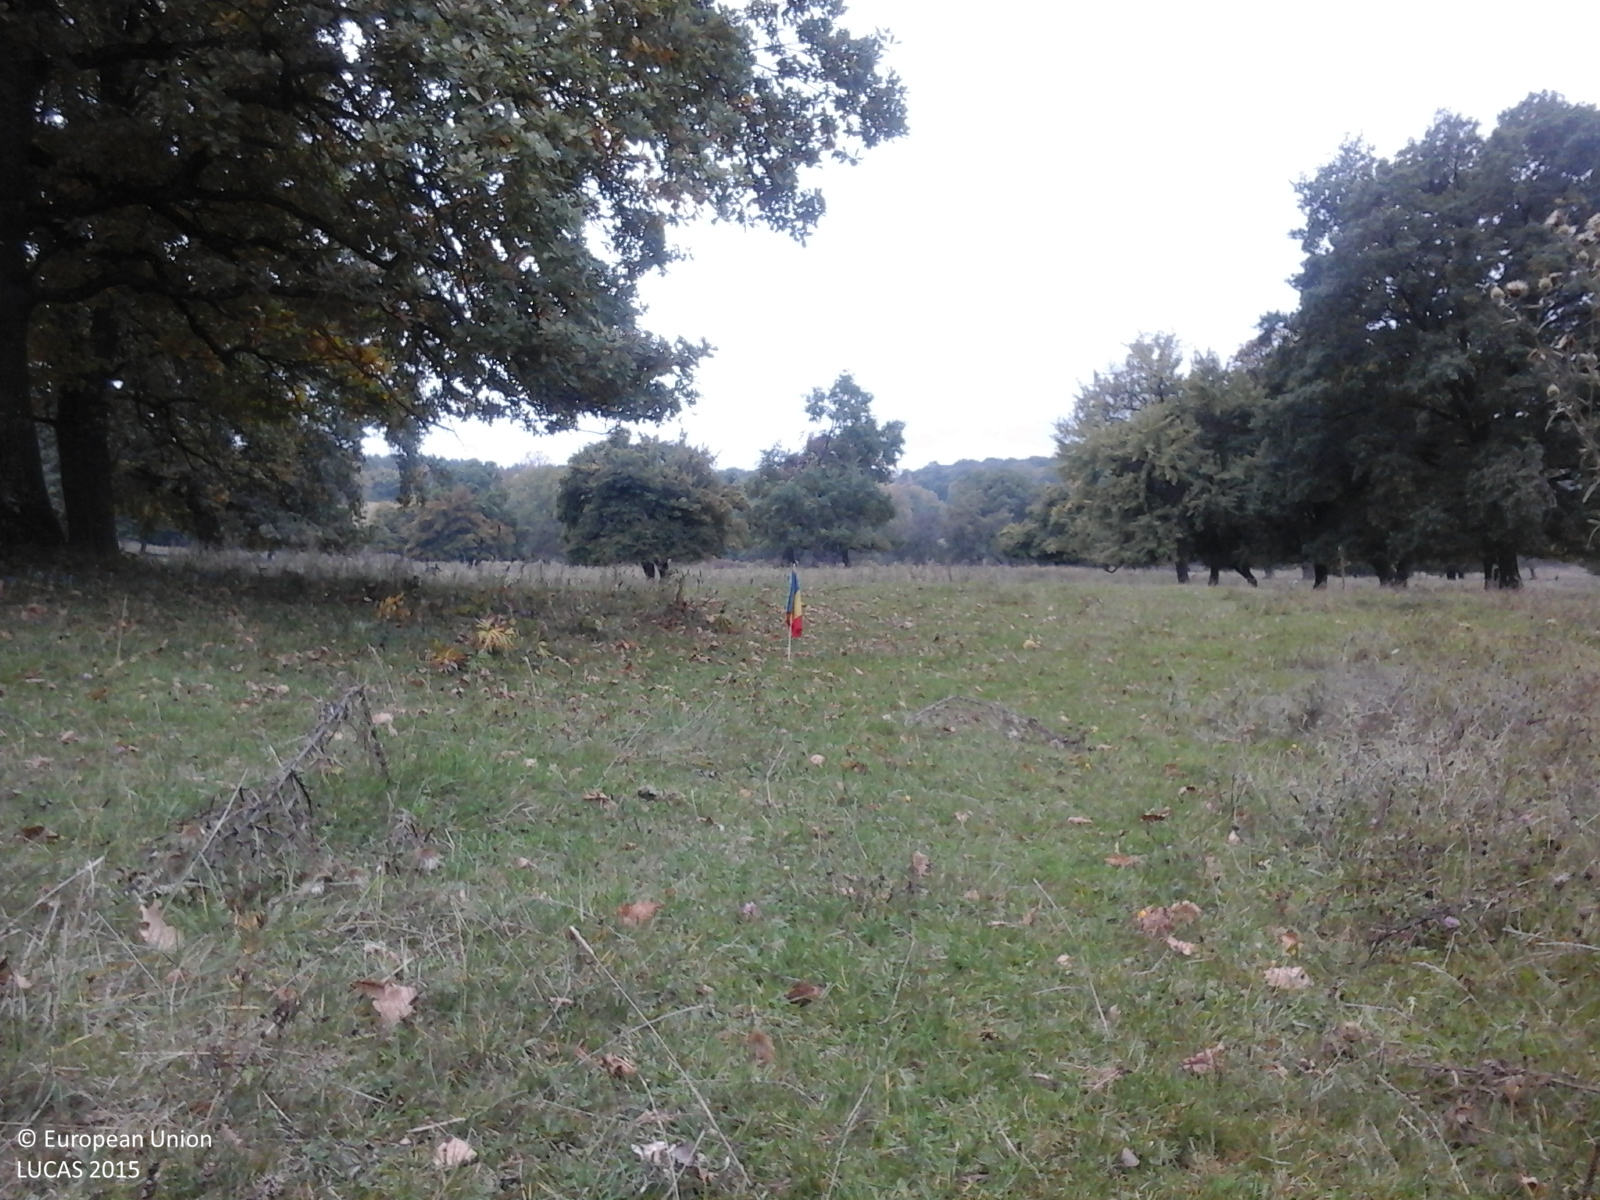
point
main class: Grassland
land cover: Grassland with sparse tree/shrub cover
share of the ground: > 75 %
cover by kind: herbaceous plants 95 %, broadleaved forest trees 5 %
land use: Agriculture (excluding fallow land and kitchen gardens)
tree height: > 5 m
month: October
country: RO
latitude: 46.0049
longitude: 25.2204
